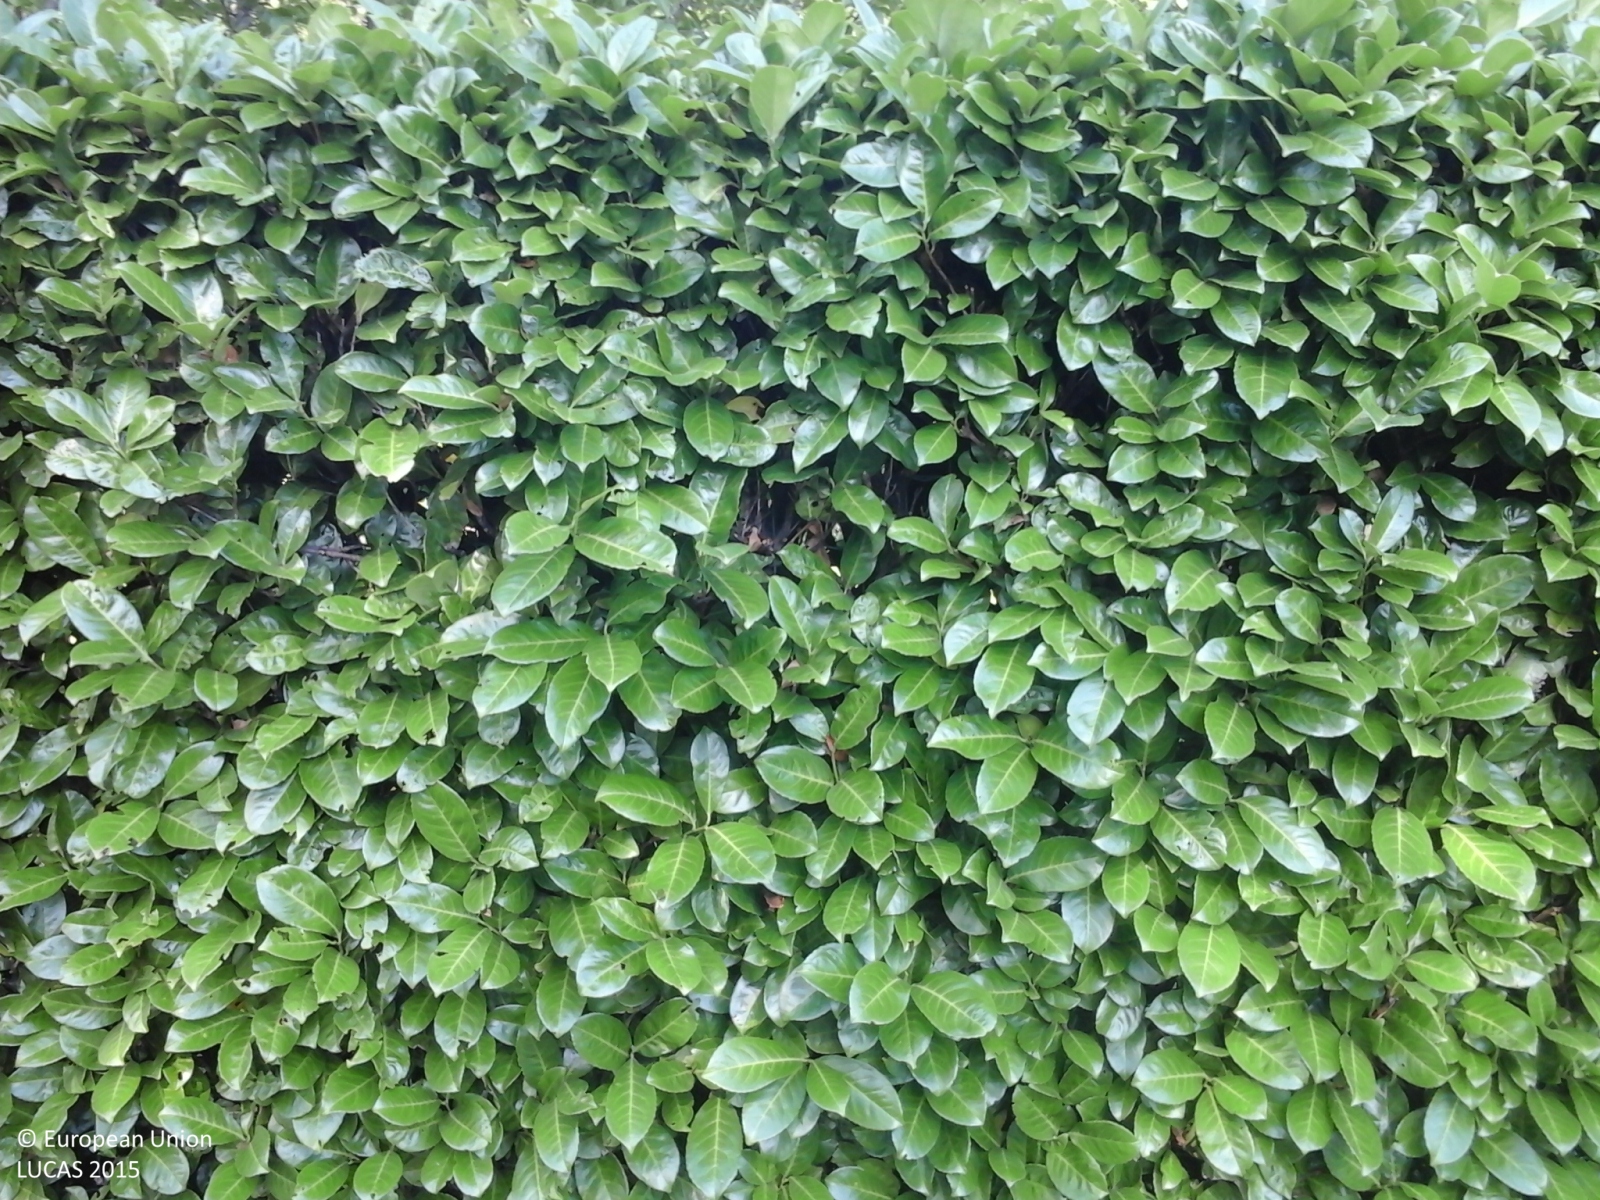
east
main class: Woodland
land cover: Broadleaved woodland
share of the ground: 50 - 75 %
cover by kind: broadleaved forest trees 75 %, herbaceous plants 15 %, coniferous forest trees 10 %
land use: Residential
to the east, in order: Broadleaved woodland; Artificial constructions in urban areas; Managed hedges; Grassland with sparse tree/shrub cover; Broadleaved woodland; Paved roads, cycling and walking lanes; Broadleaved woodland; Paved roads, cycling and walking lanes; Broadleaved woodland; Artificial constructions in urban areas; Broadleaved woodland
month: June
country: IT
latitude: 45.6819
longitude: 9.2437
